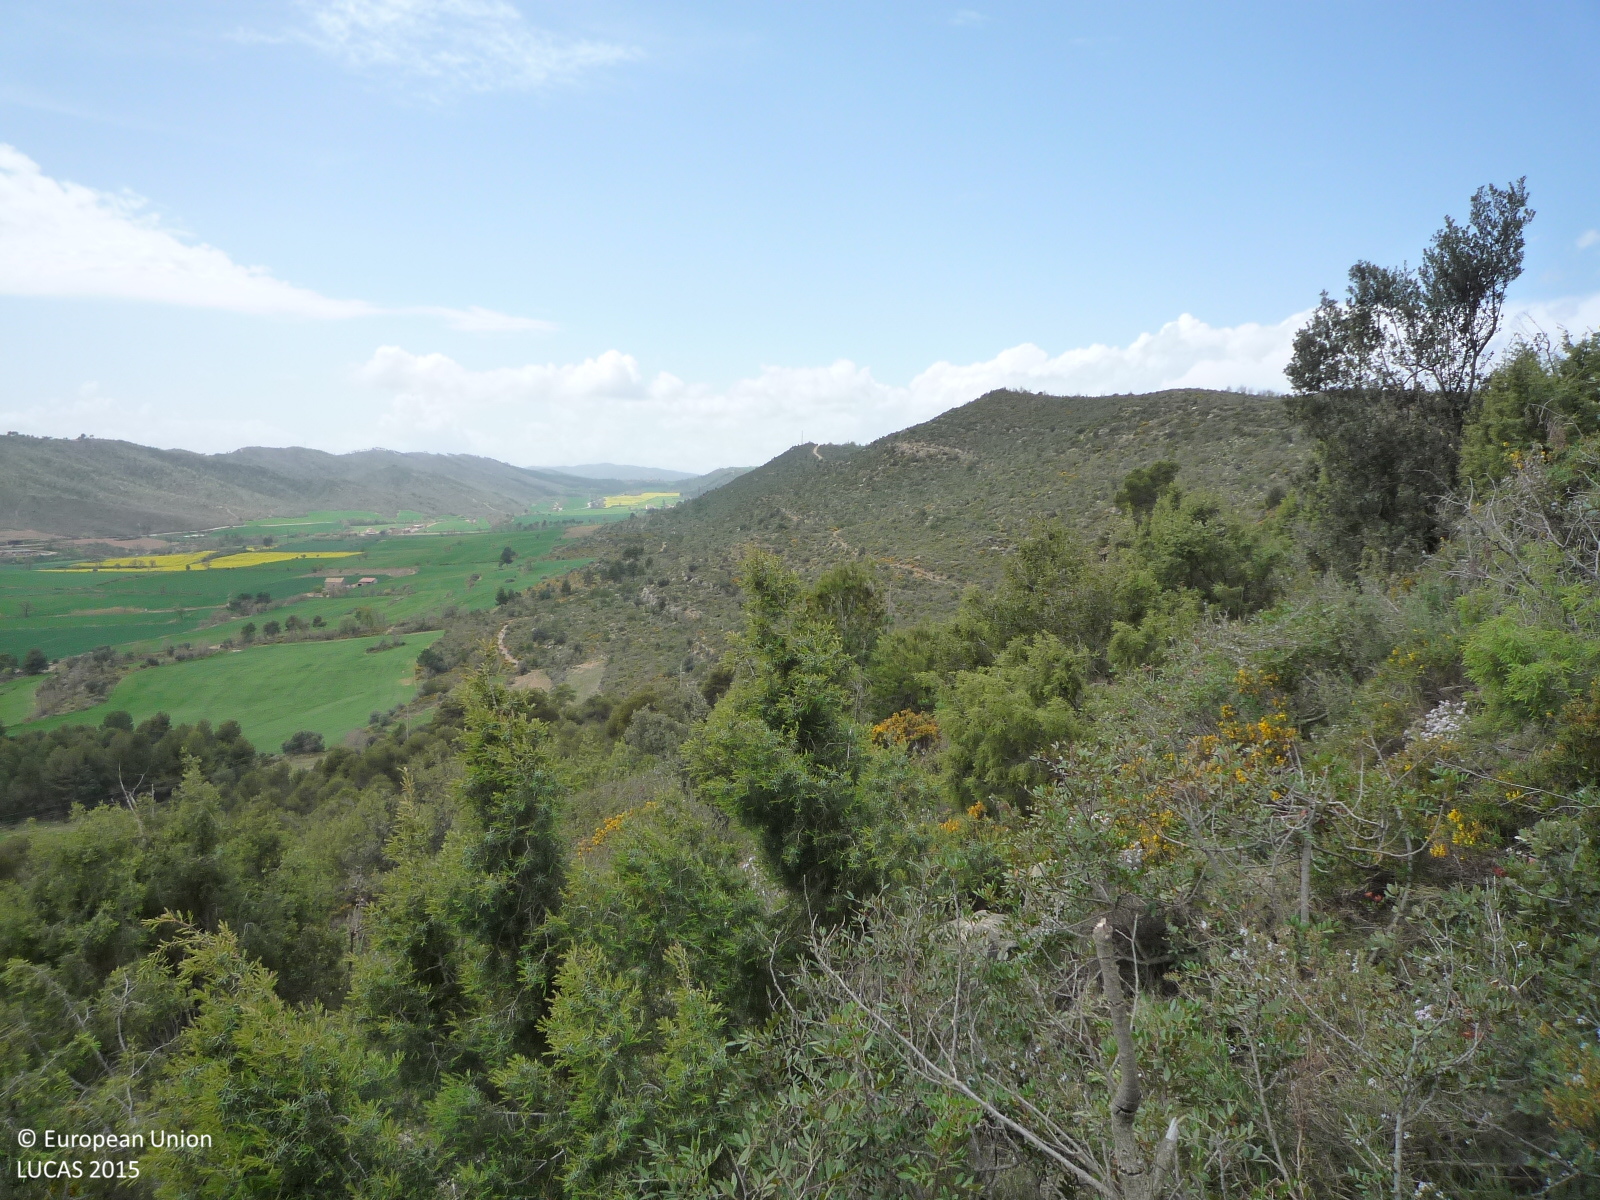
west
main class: Shrubland
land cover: Shrubland without tree cover
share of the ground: > 75 %
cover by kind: shrubs 75 %, lichens and mosses 15 %, herbaceous plants 10 %
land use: Semi-natural and natural areas not in use
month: April
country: ES
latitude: 41.9281
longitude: 1.6564
